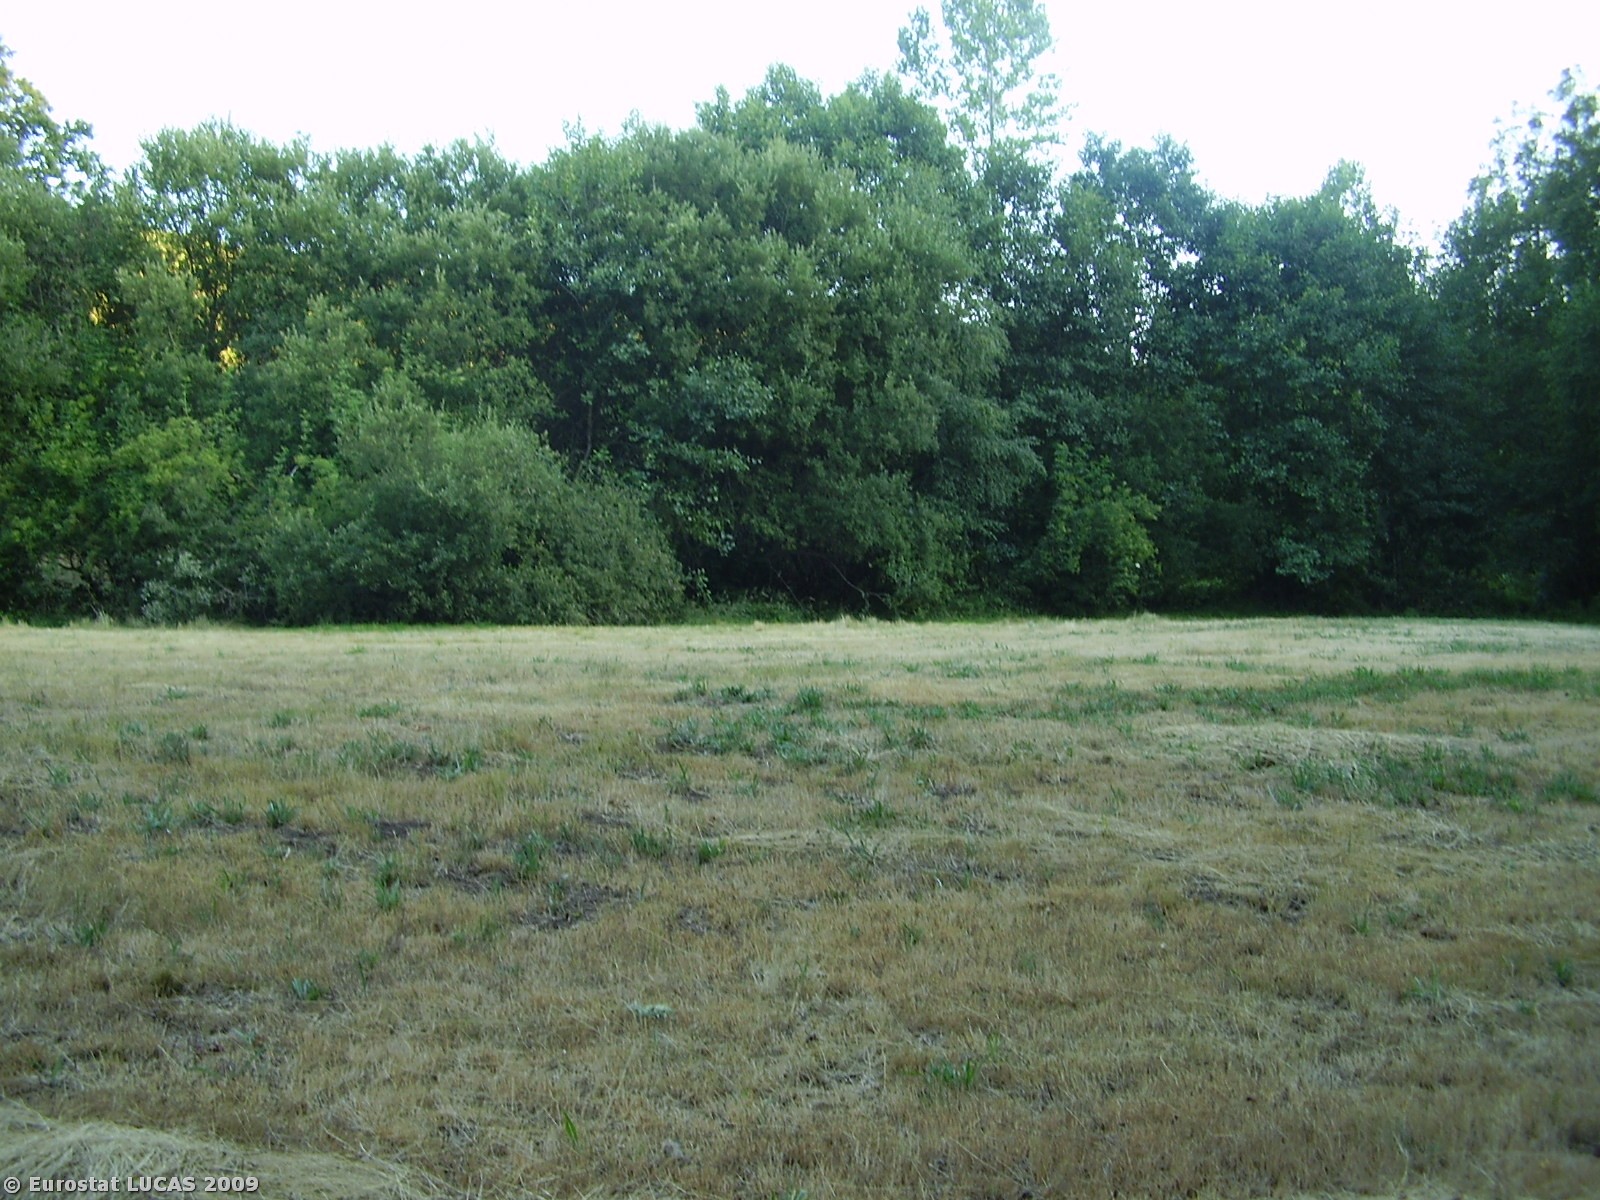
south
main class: Grassland
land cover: Grassland without tree/shrub cover
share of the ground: > 75 %
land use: Agriculture (excluding fallow land and kitchen gardens)
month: July
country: PT
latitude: 41.5327
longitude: -7.5438
